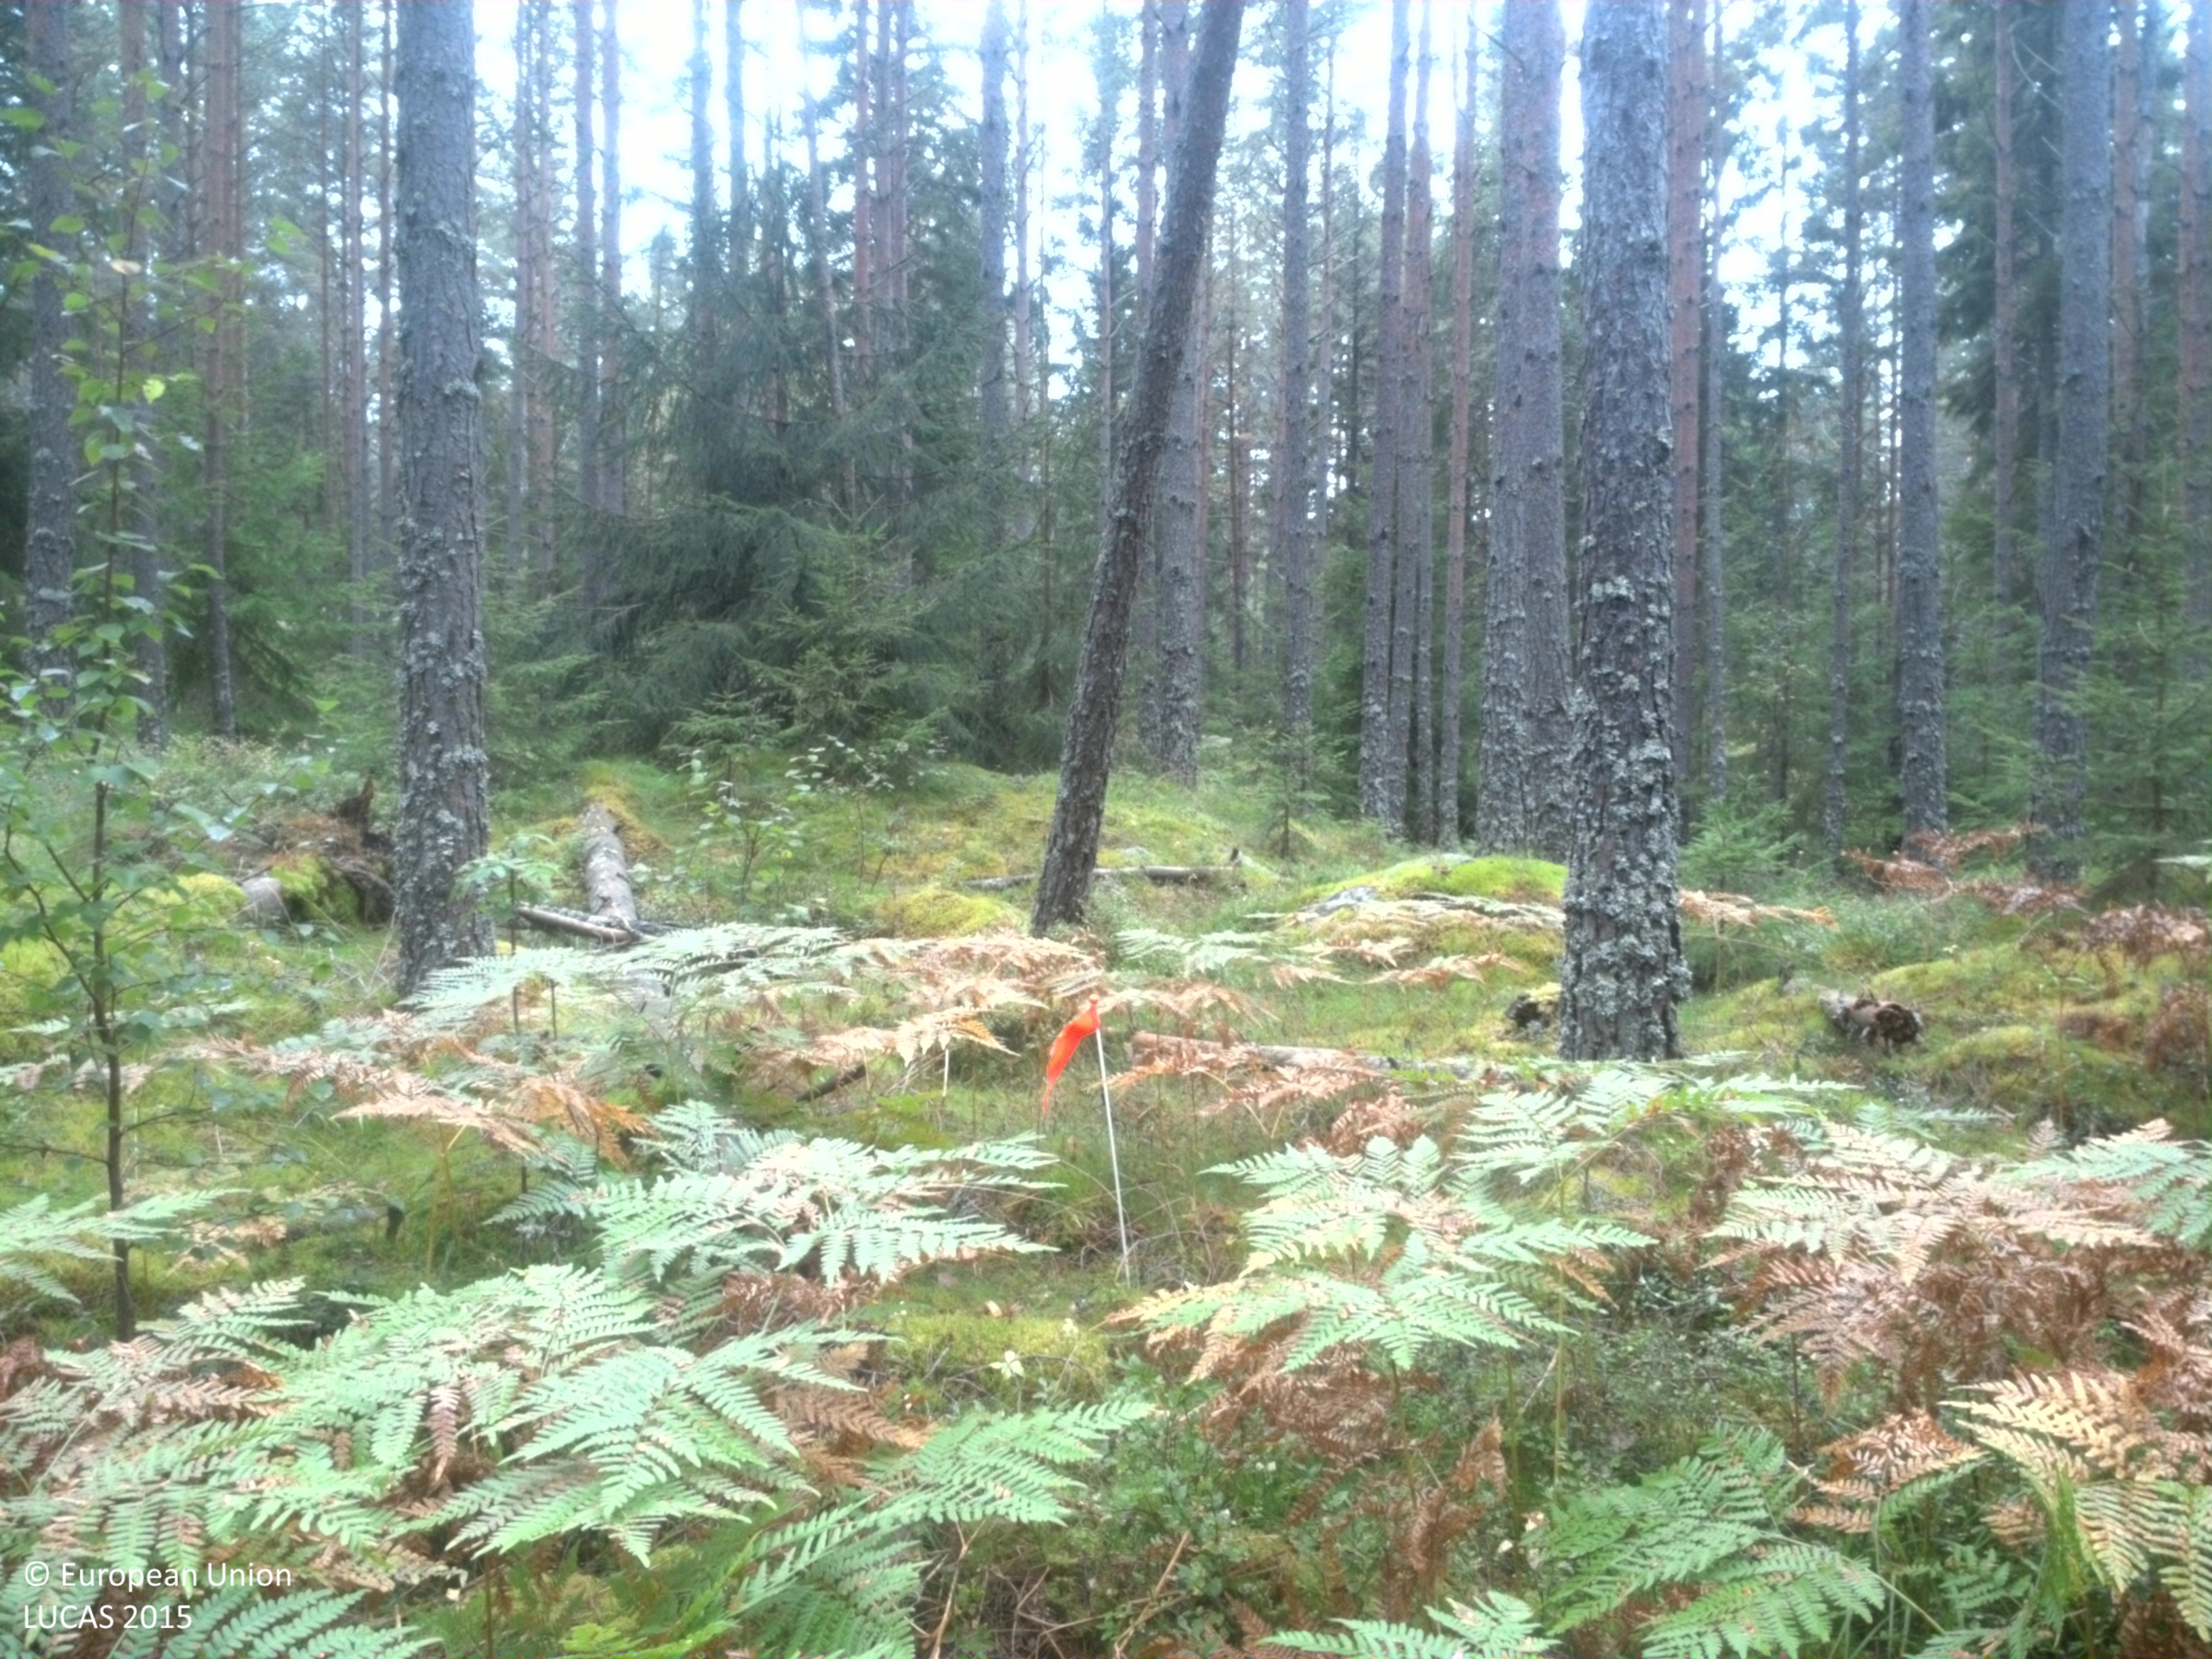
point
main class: Woodland
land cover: Pine dominated coniferous woodland
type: boreal forest
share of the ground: 50 - 75 %
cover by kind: coniferous forest trees 70 %, lichens and mosses 15 %, shrubs 10 %, herbaceous plants 5 %
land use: Forestry
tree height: > 5 m
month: September
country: SE
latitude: 59.6552
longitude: 15.5806
